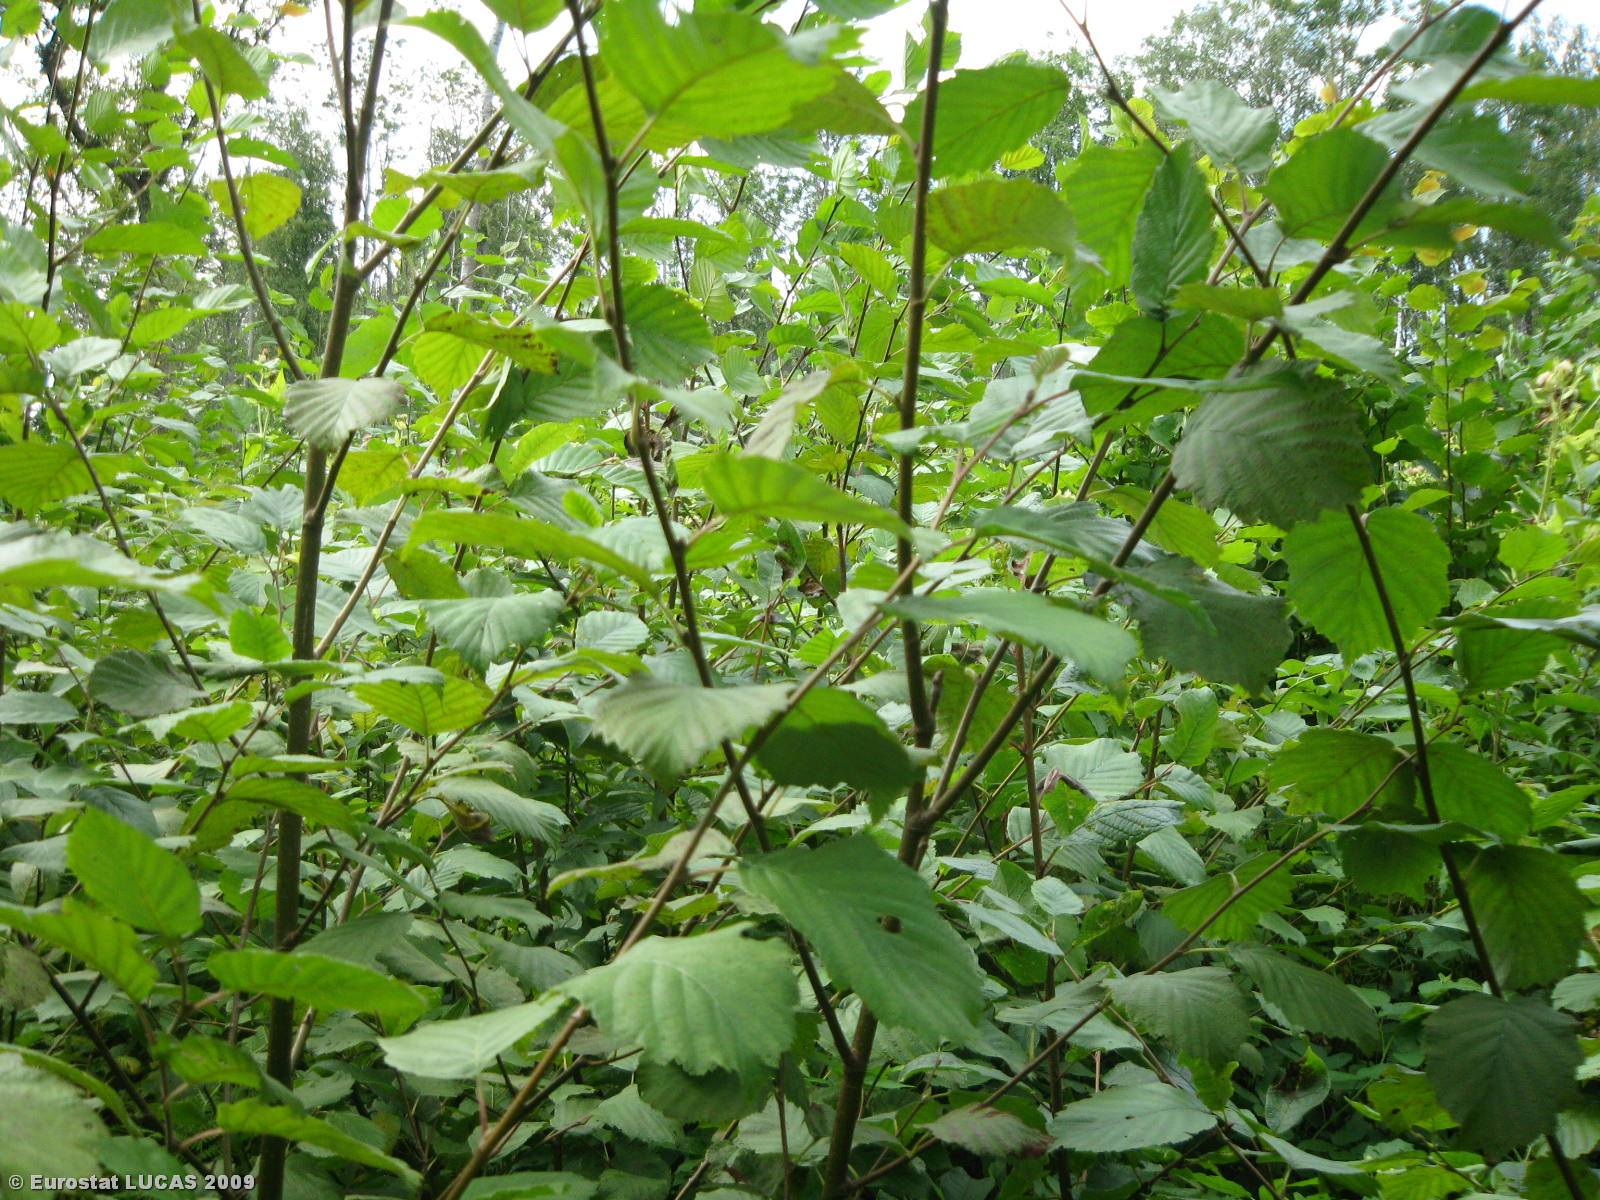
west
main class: Woodland
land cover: Broadleaved woodland
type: mesophytic deciduous forest
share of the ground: > 75 %
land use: Forestry
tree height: > 5 m
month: August
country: LT
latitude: 56.2402
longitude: 24.1429
